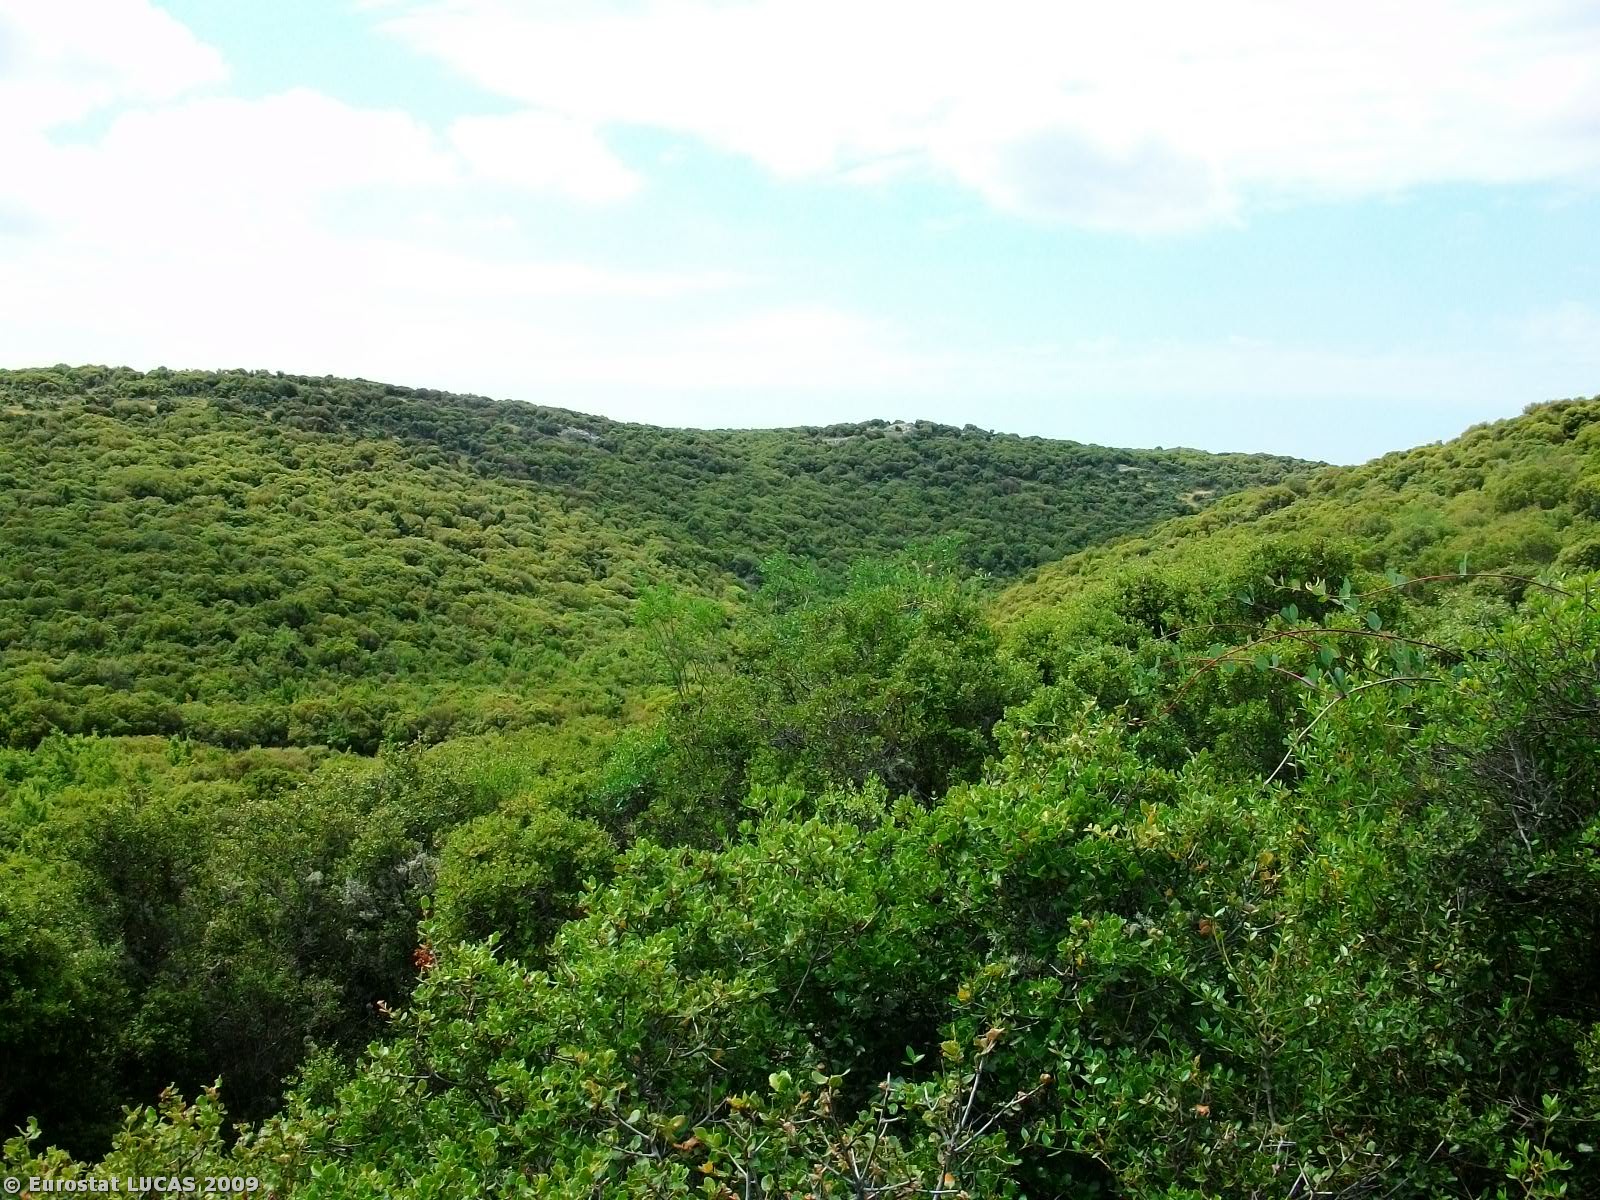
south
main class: Shrubland
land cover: Shrubland without tree cover
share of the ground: > 75 %
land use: Unused
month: May
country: GR
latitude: 40.9629
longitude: 25.4602
